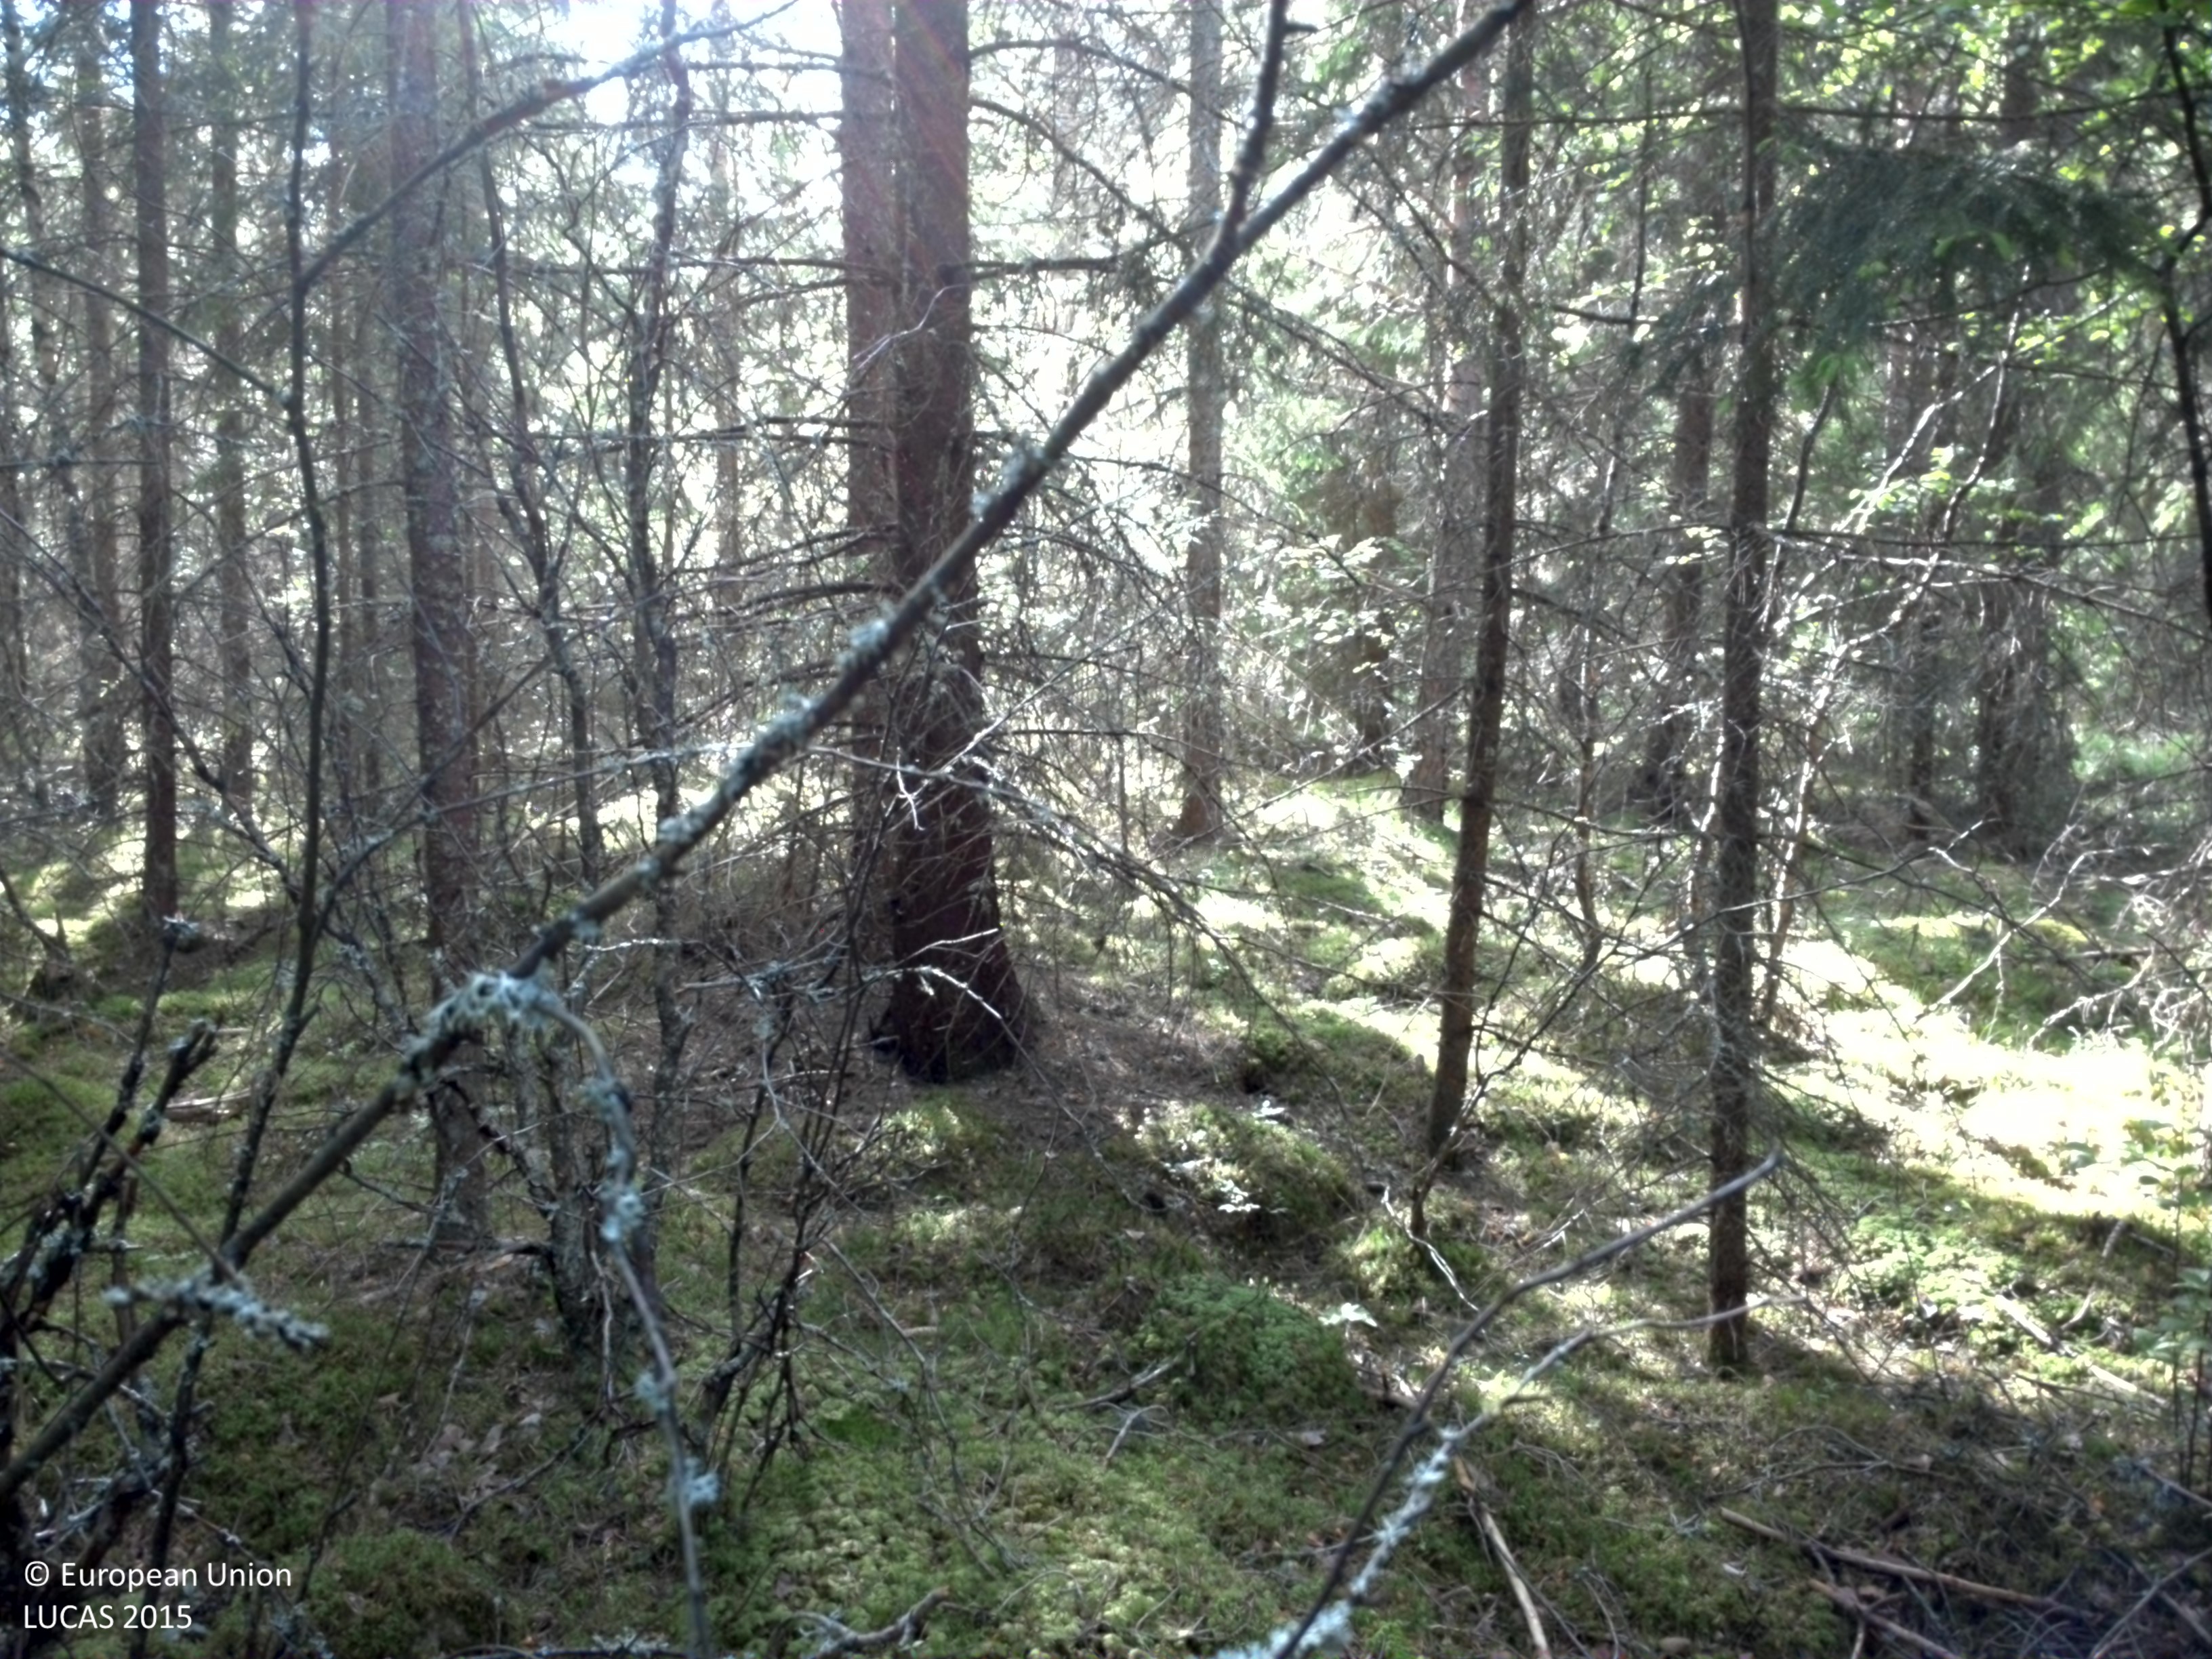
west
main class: Woodland
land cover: Spruce dominated coniferous woodland
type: boreal forest
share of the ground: > 75 %
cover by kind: coniferous forest trees 75 %, lichens and mosses 15 %, broadleaved forest trees 5 %, herbaceous plants 5 %
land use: Forestry
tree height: > 5 m
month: June
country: SE
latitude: 59.5778
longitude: 14.1871
